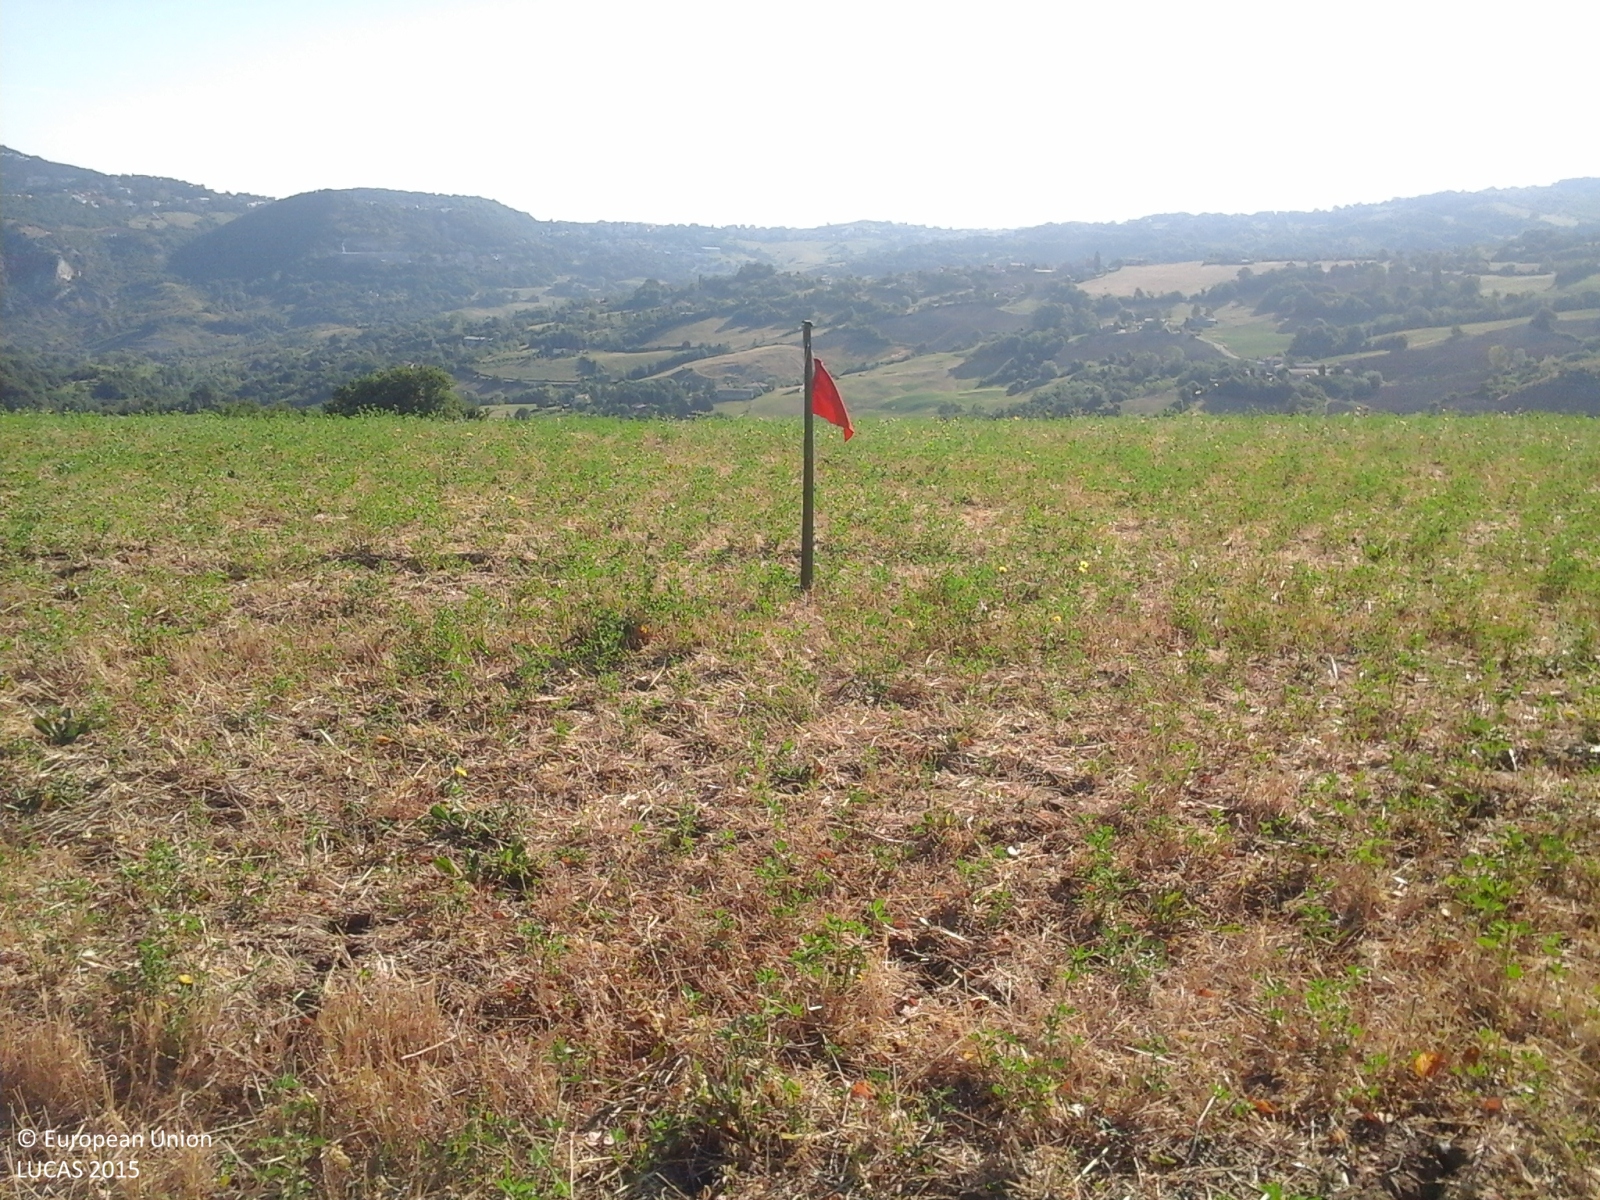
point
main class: Cropland
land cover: Lucerne
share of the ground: > 75 %
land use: Agriculture (excluding fallow land and kitchen gardens)
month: July
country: IT
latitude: 43.8892
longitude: 12.4215
